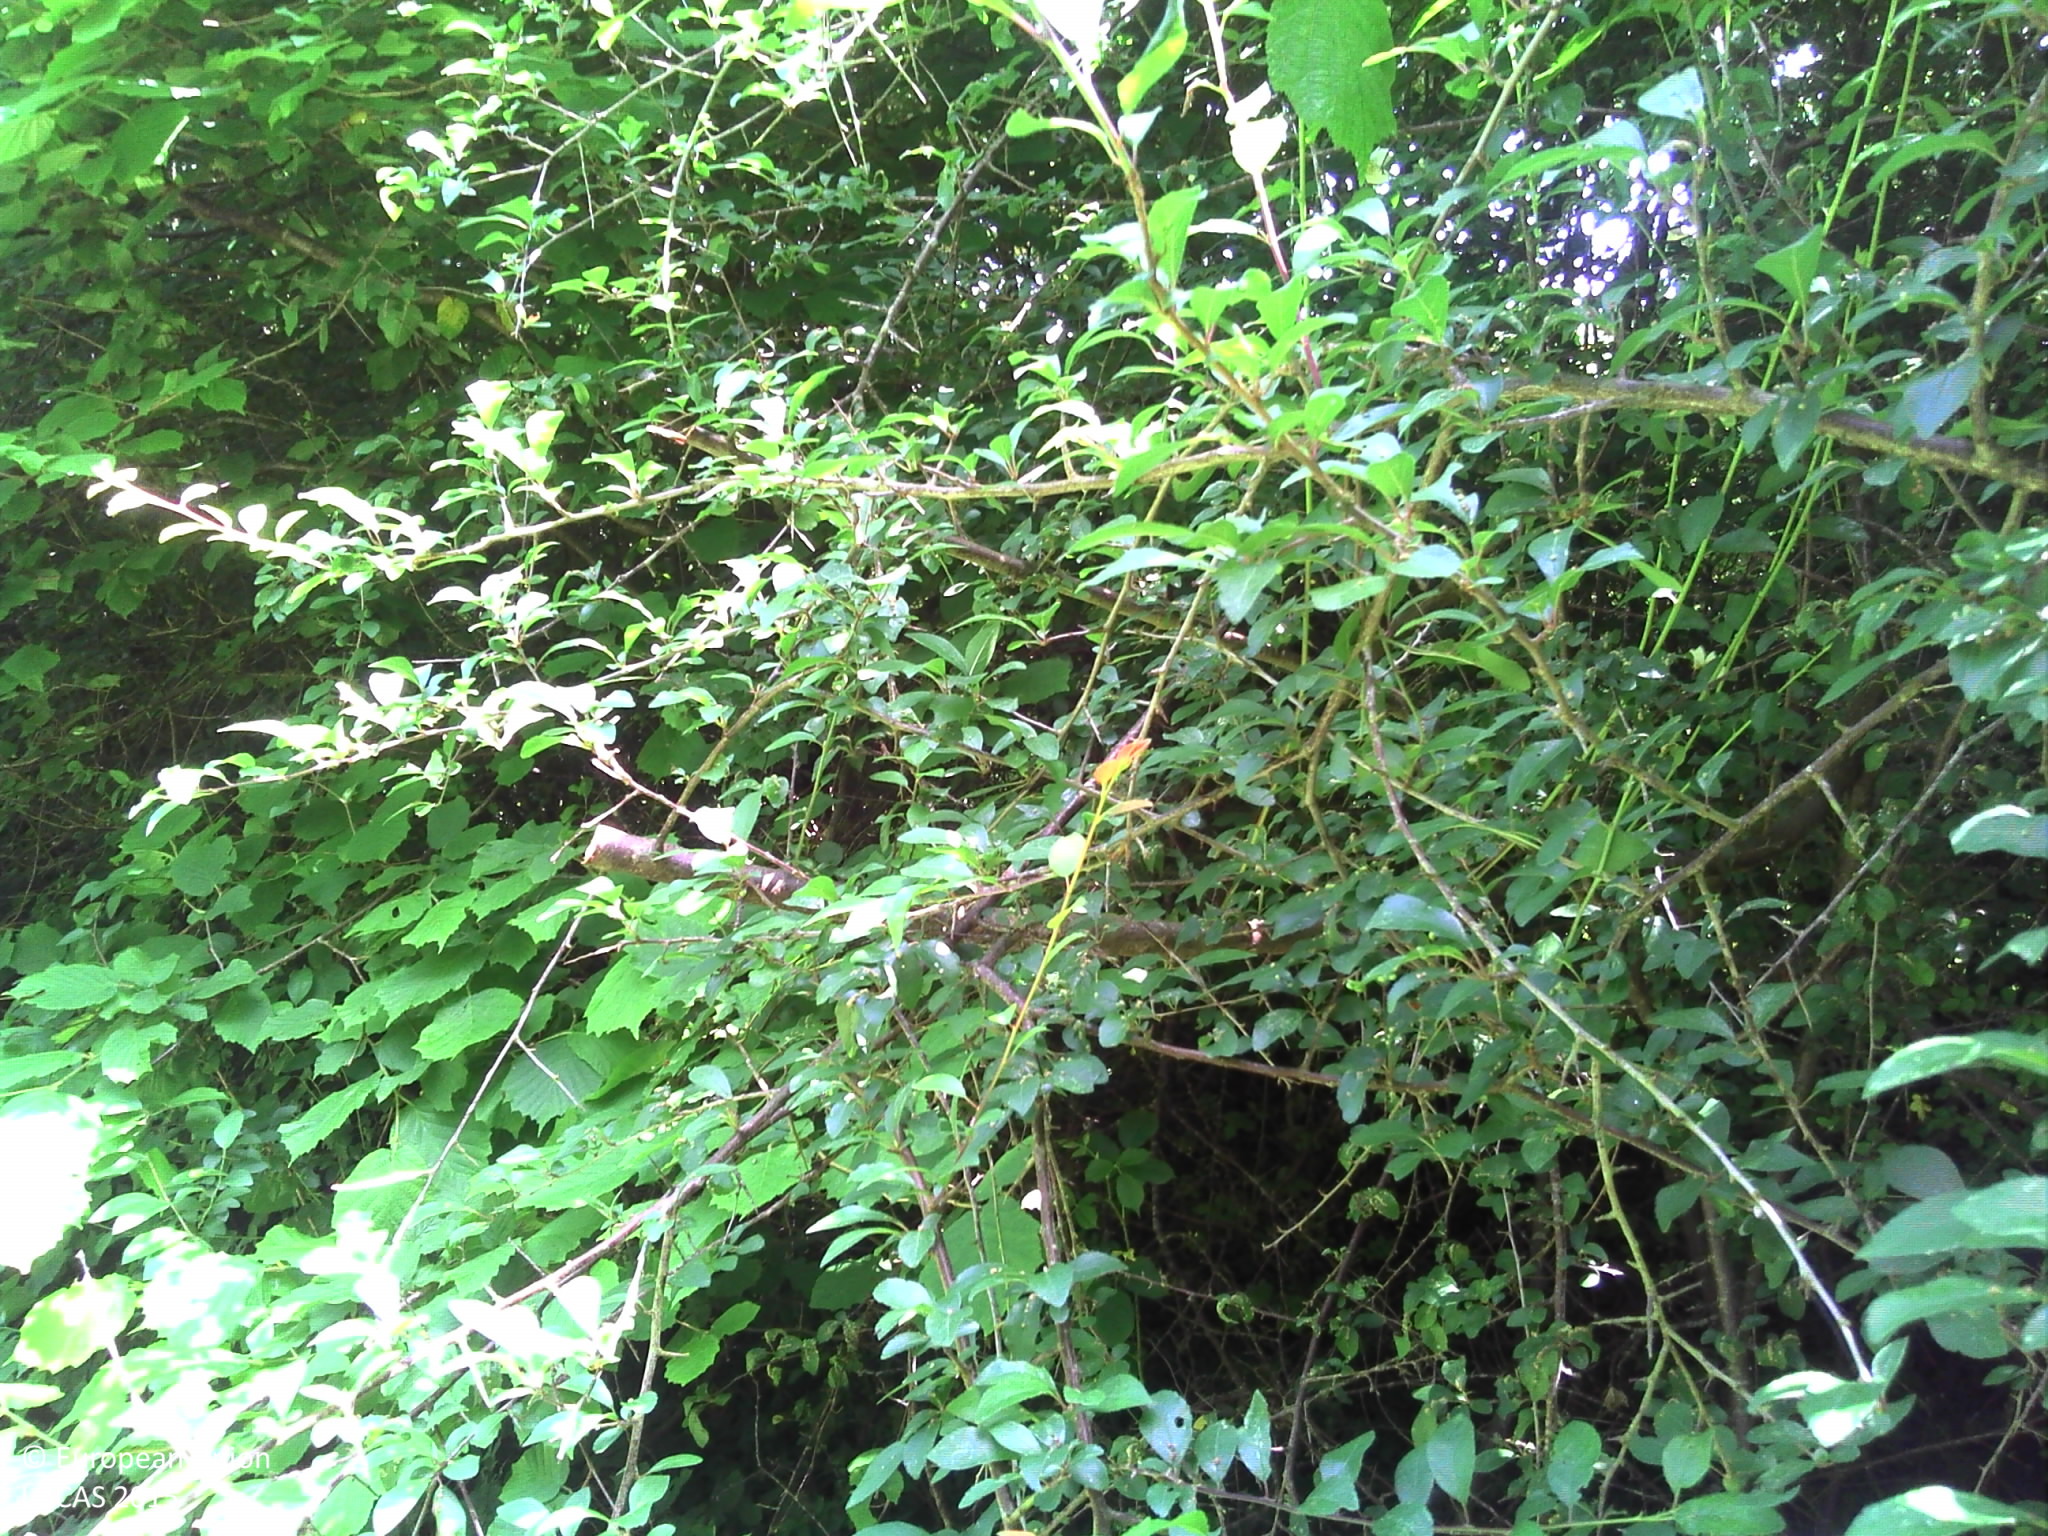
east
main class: Woodland
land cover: Broadleaved woodland
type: mesophytic deciduous forest
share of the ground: > 75 %
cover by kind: broadleaved forest trees 95 %, lichens and mosses 5 %
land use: Forestry
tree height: > 5 m
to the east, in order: Broadleaved woodland; Fences; Ditches and canals; Tracks; Ditches and canals; Managed hedges; Maize; Grass margins; Electric lines; Ditches and canals; Grass margins; Paved roads, cycling and walking lanes; Grass margins; Durum wheat; Broadleaved woodland
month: June
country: FR
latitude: 48.5938
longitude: 0.1141
